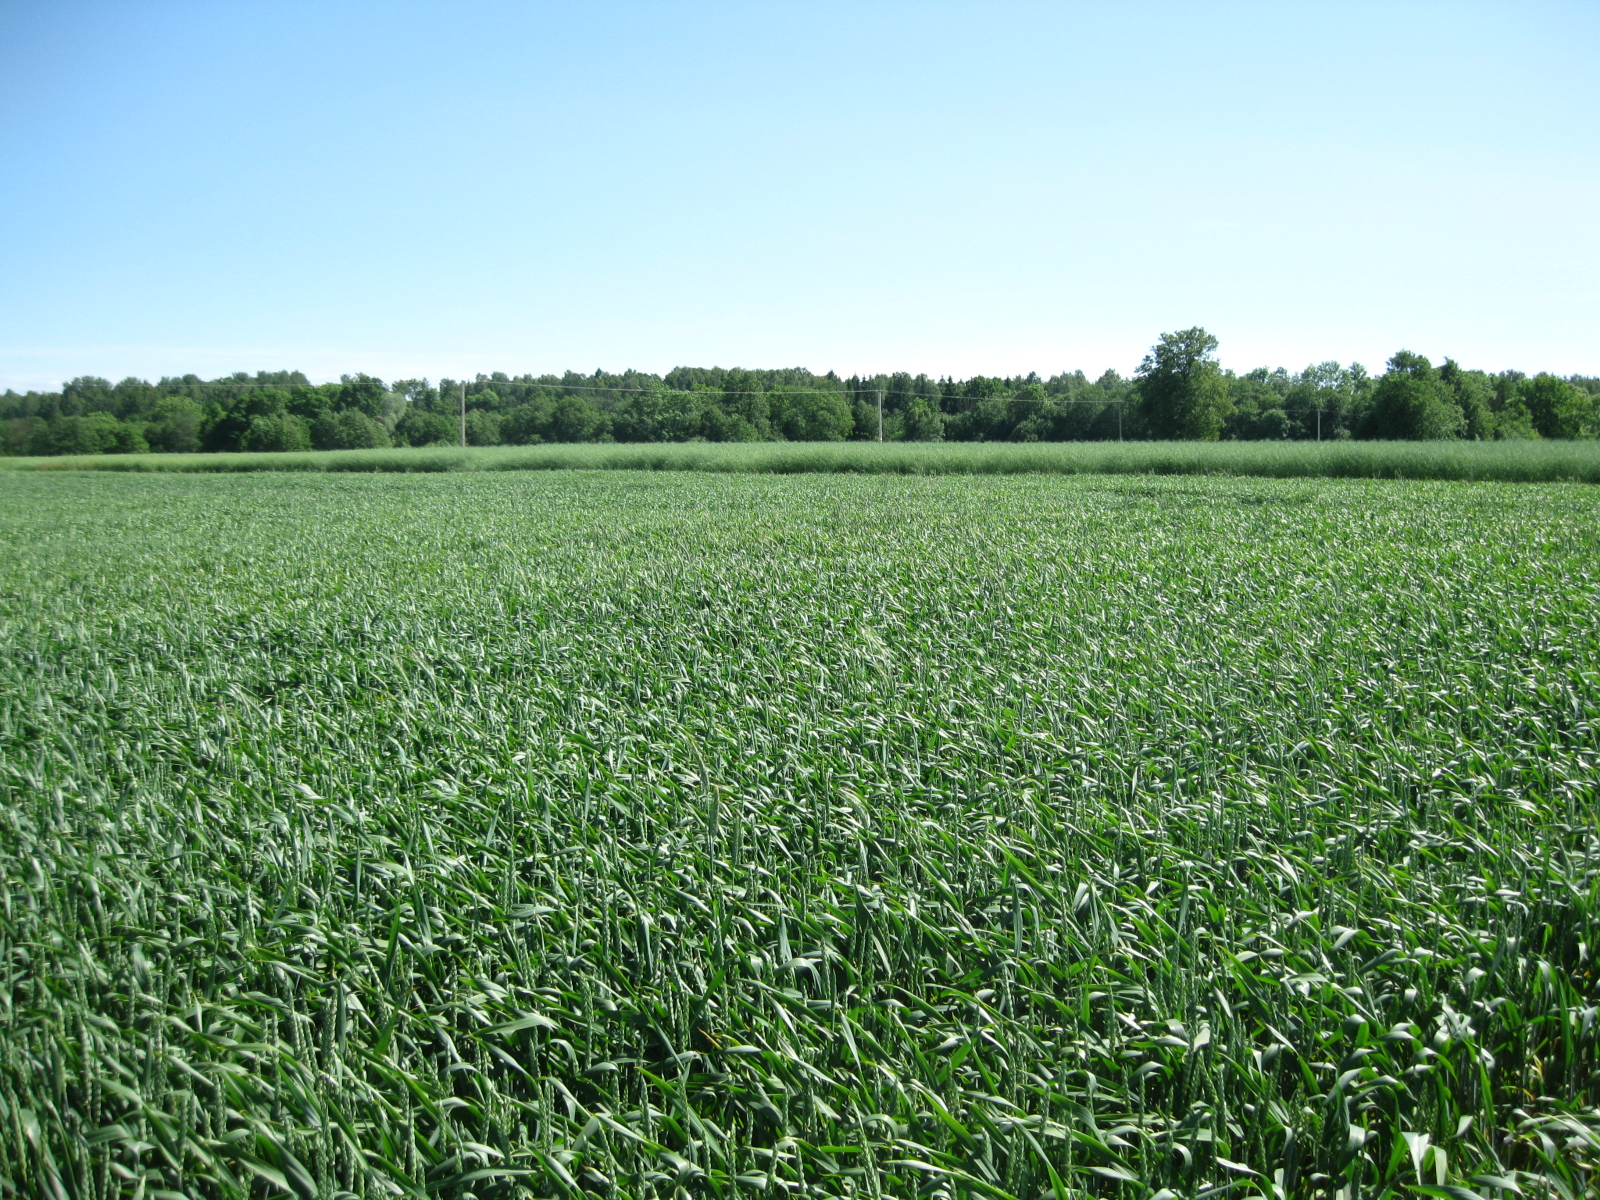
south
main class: Cropland
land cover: Common wheat
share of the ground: > 75 %
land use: Agriculture (excluding fallow land and kitchen gardens)
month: June
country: LT
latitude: 55.2557
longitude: 23.7893
